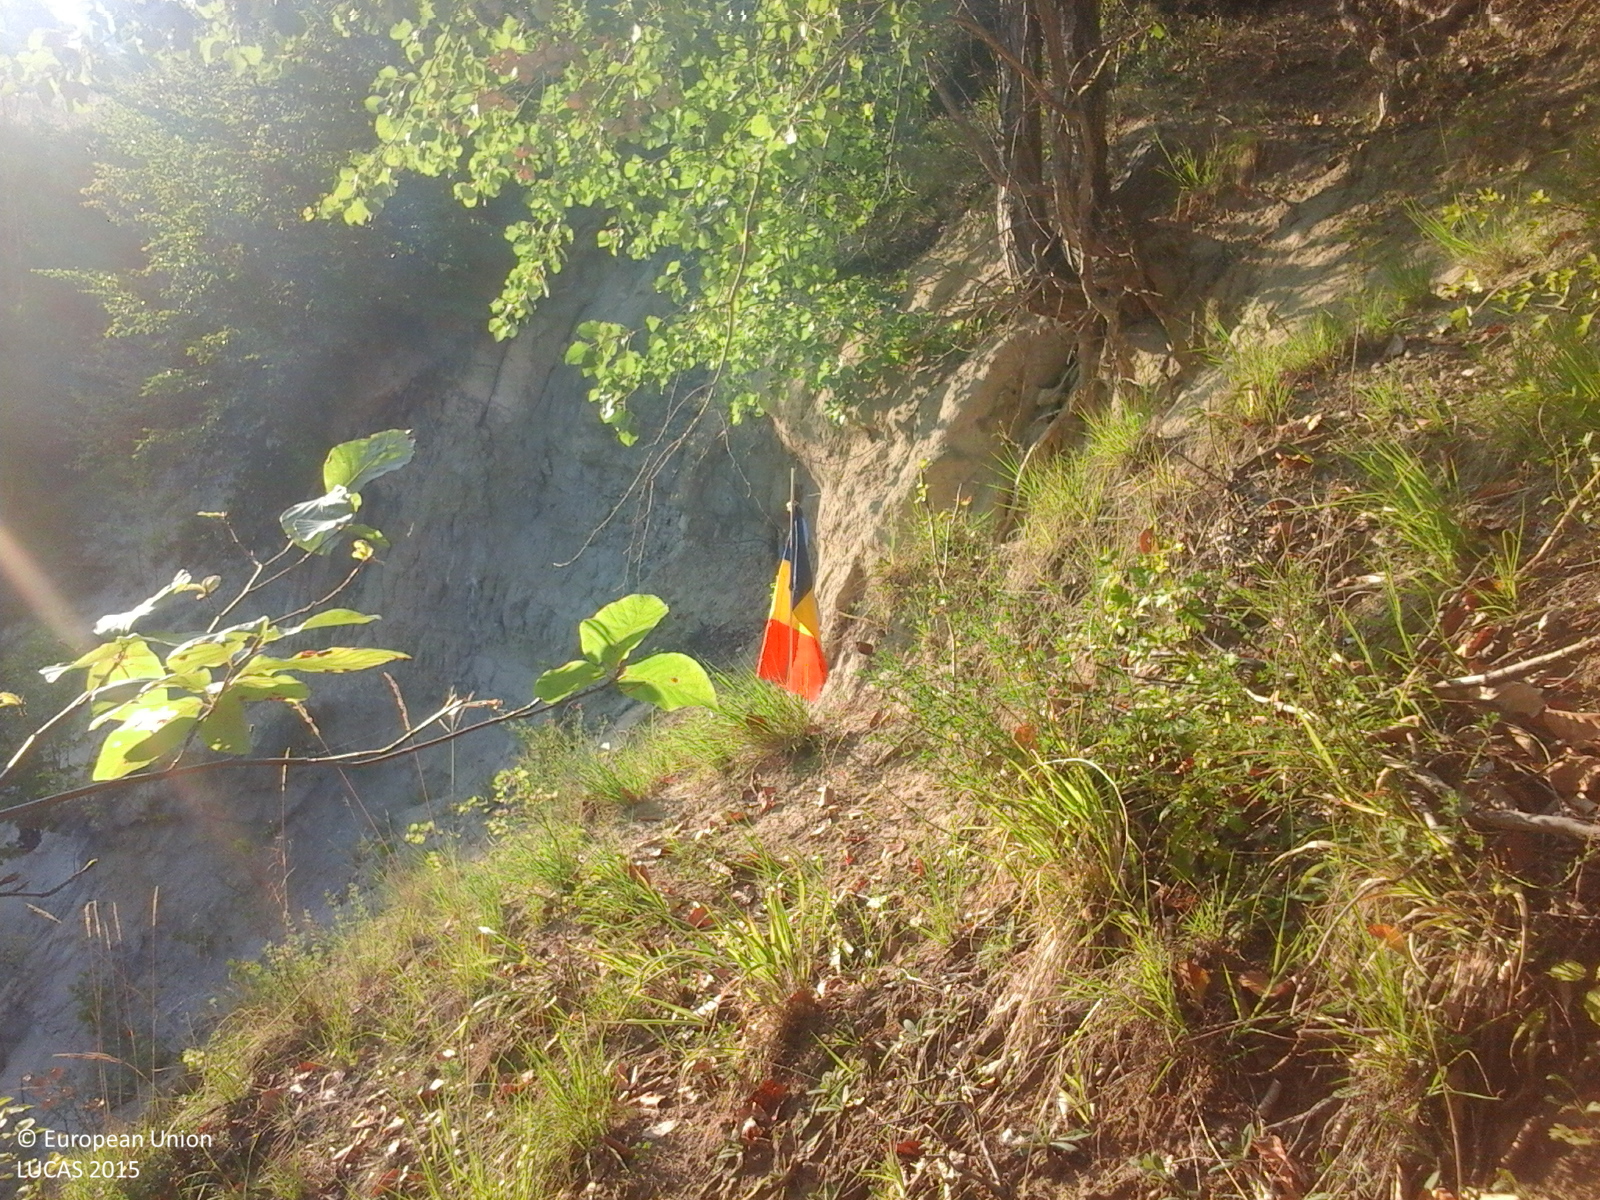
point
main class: Woodland
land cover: Broadleaved woodland
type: beech forest
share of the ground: > 75 %
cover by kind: broadleaved forest trees 100 %
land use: Forestry
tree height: > 5 m
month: August
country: RO
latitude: 46.3068
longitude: 26.8531
